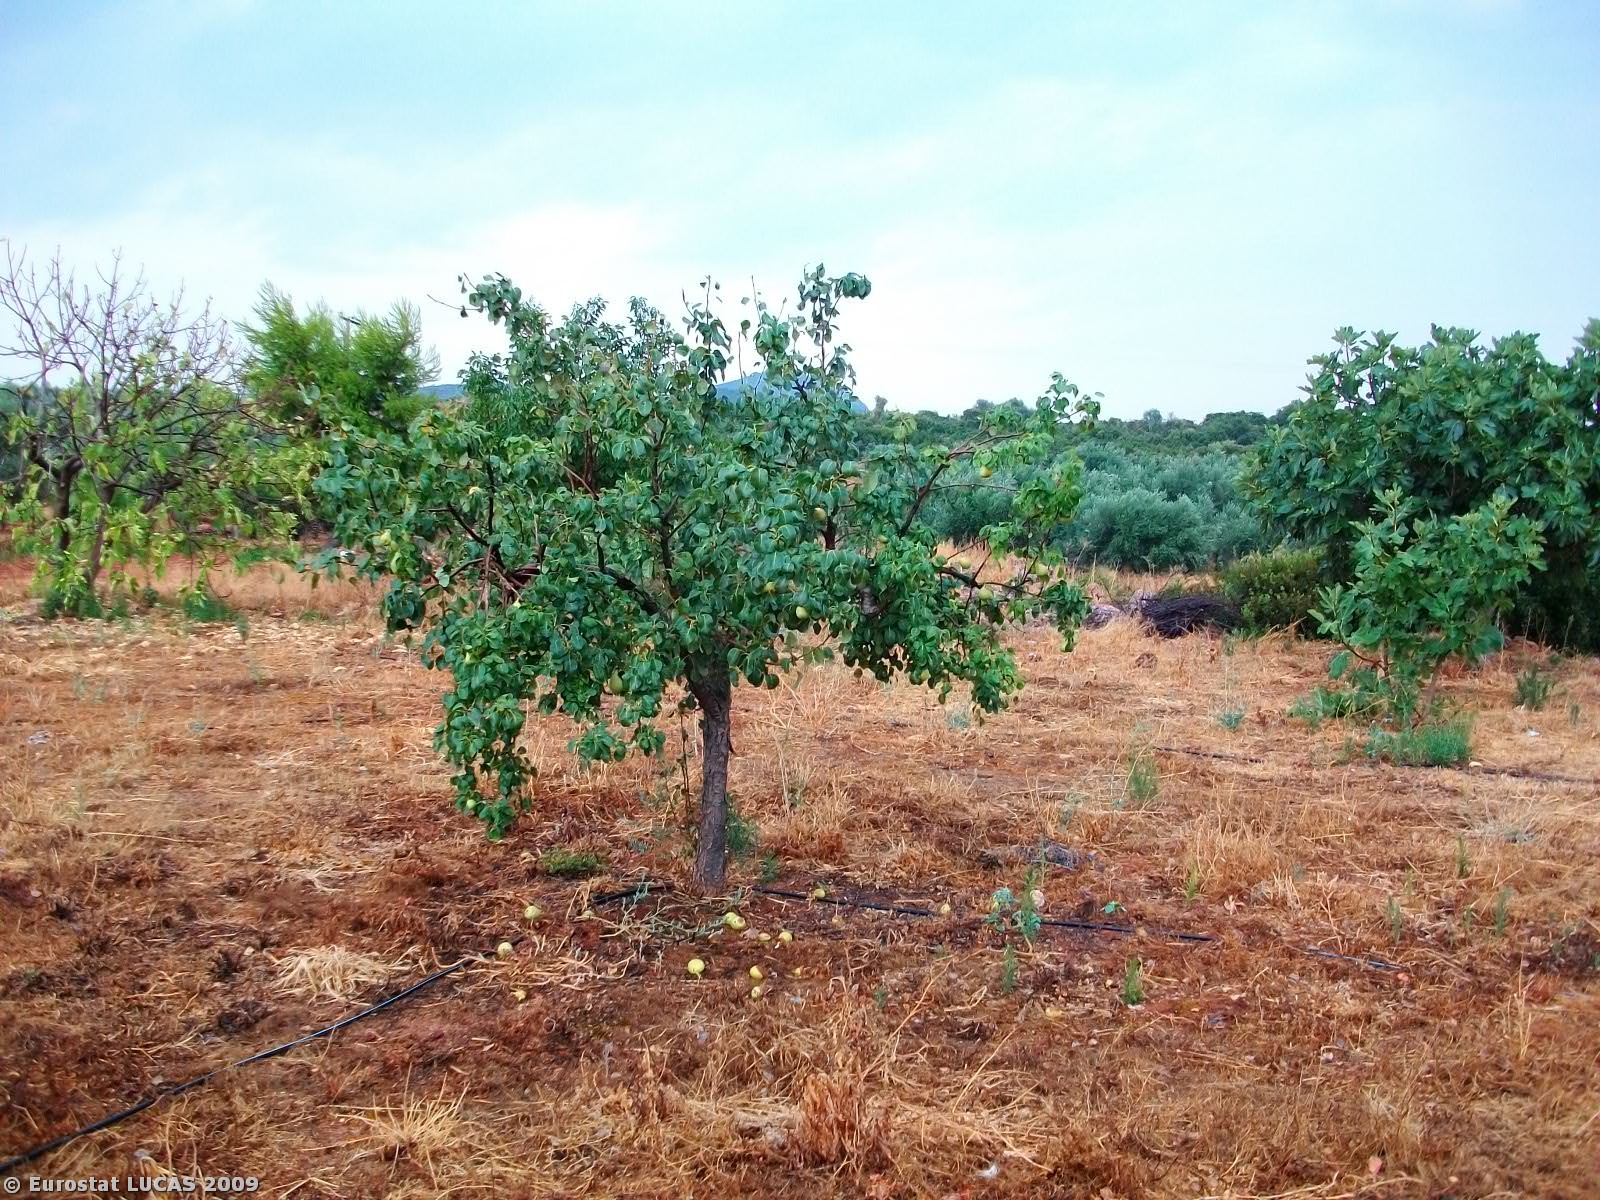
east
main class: Cropland
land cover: Pear fruit
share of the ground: 10 - 25 %
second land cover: Grassland with sparse tree/shrub cover
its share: > 75 %
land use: Agriculture (excluding fallow land and kitchen gardens)
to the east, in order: Pear fruit; Grassland with sparse tree/shrub cover; Grassland without tree/shrub cover; Olive groves; Bare land; Electric lines; Olive groves; Bare land; Shrubland without tree cover; Olive groves; Bare land
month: August
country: GR
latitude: 36.9054
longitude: 22.7386
